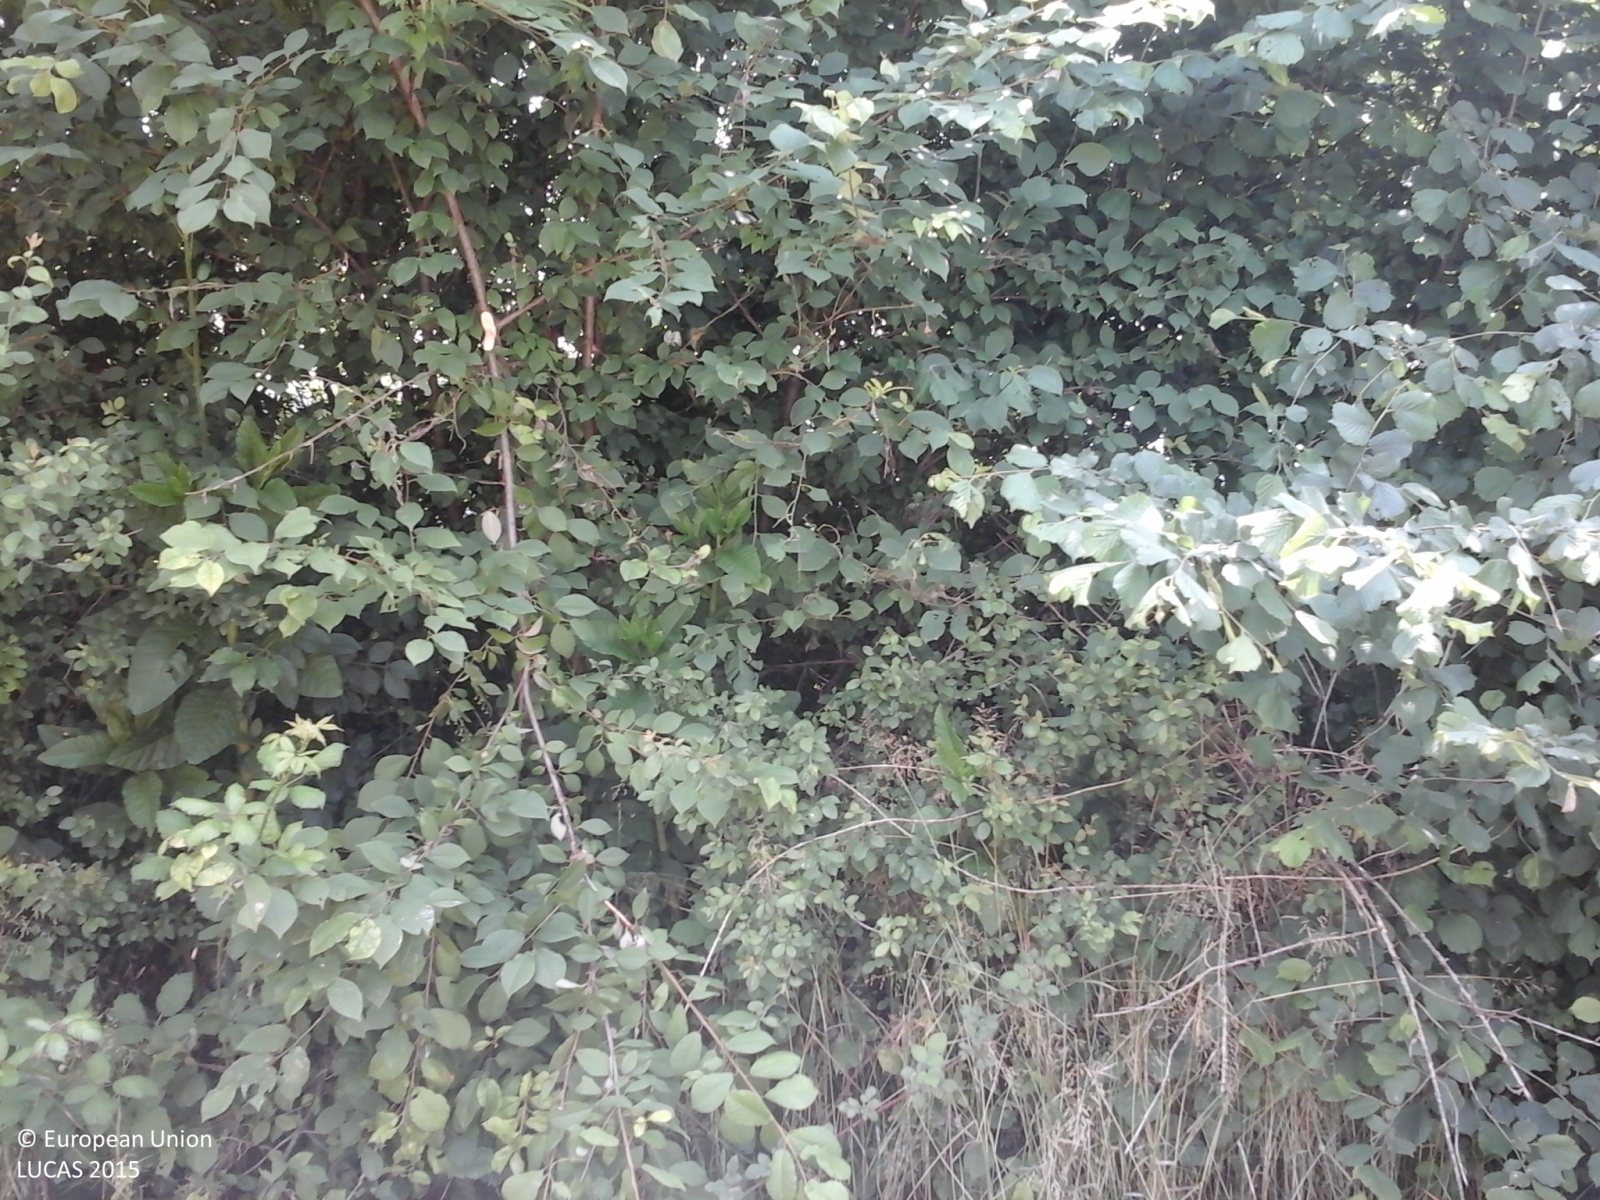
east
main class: Cropland
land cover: Soya
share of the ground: > 75 %
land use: Agriculture (excluding fallow land and kitchen gardens)
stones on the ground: < 10 %
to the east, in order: Soya; Managed hedges; Grassland without tree/shrub cover; Electric lines; Grassland without tree/shrub cover; Managed hedges; Soya; Ditches and canals; Soya
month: May
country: IT
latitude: 45.2460
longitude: 7.7487
